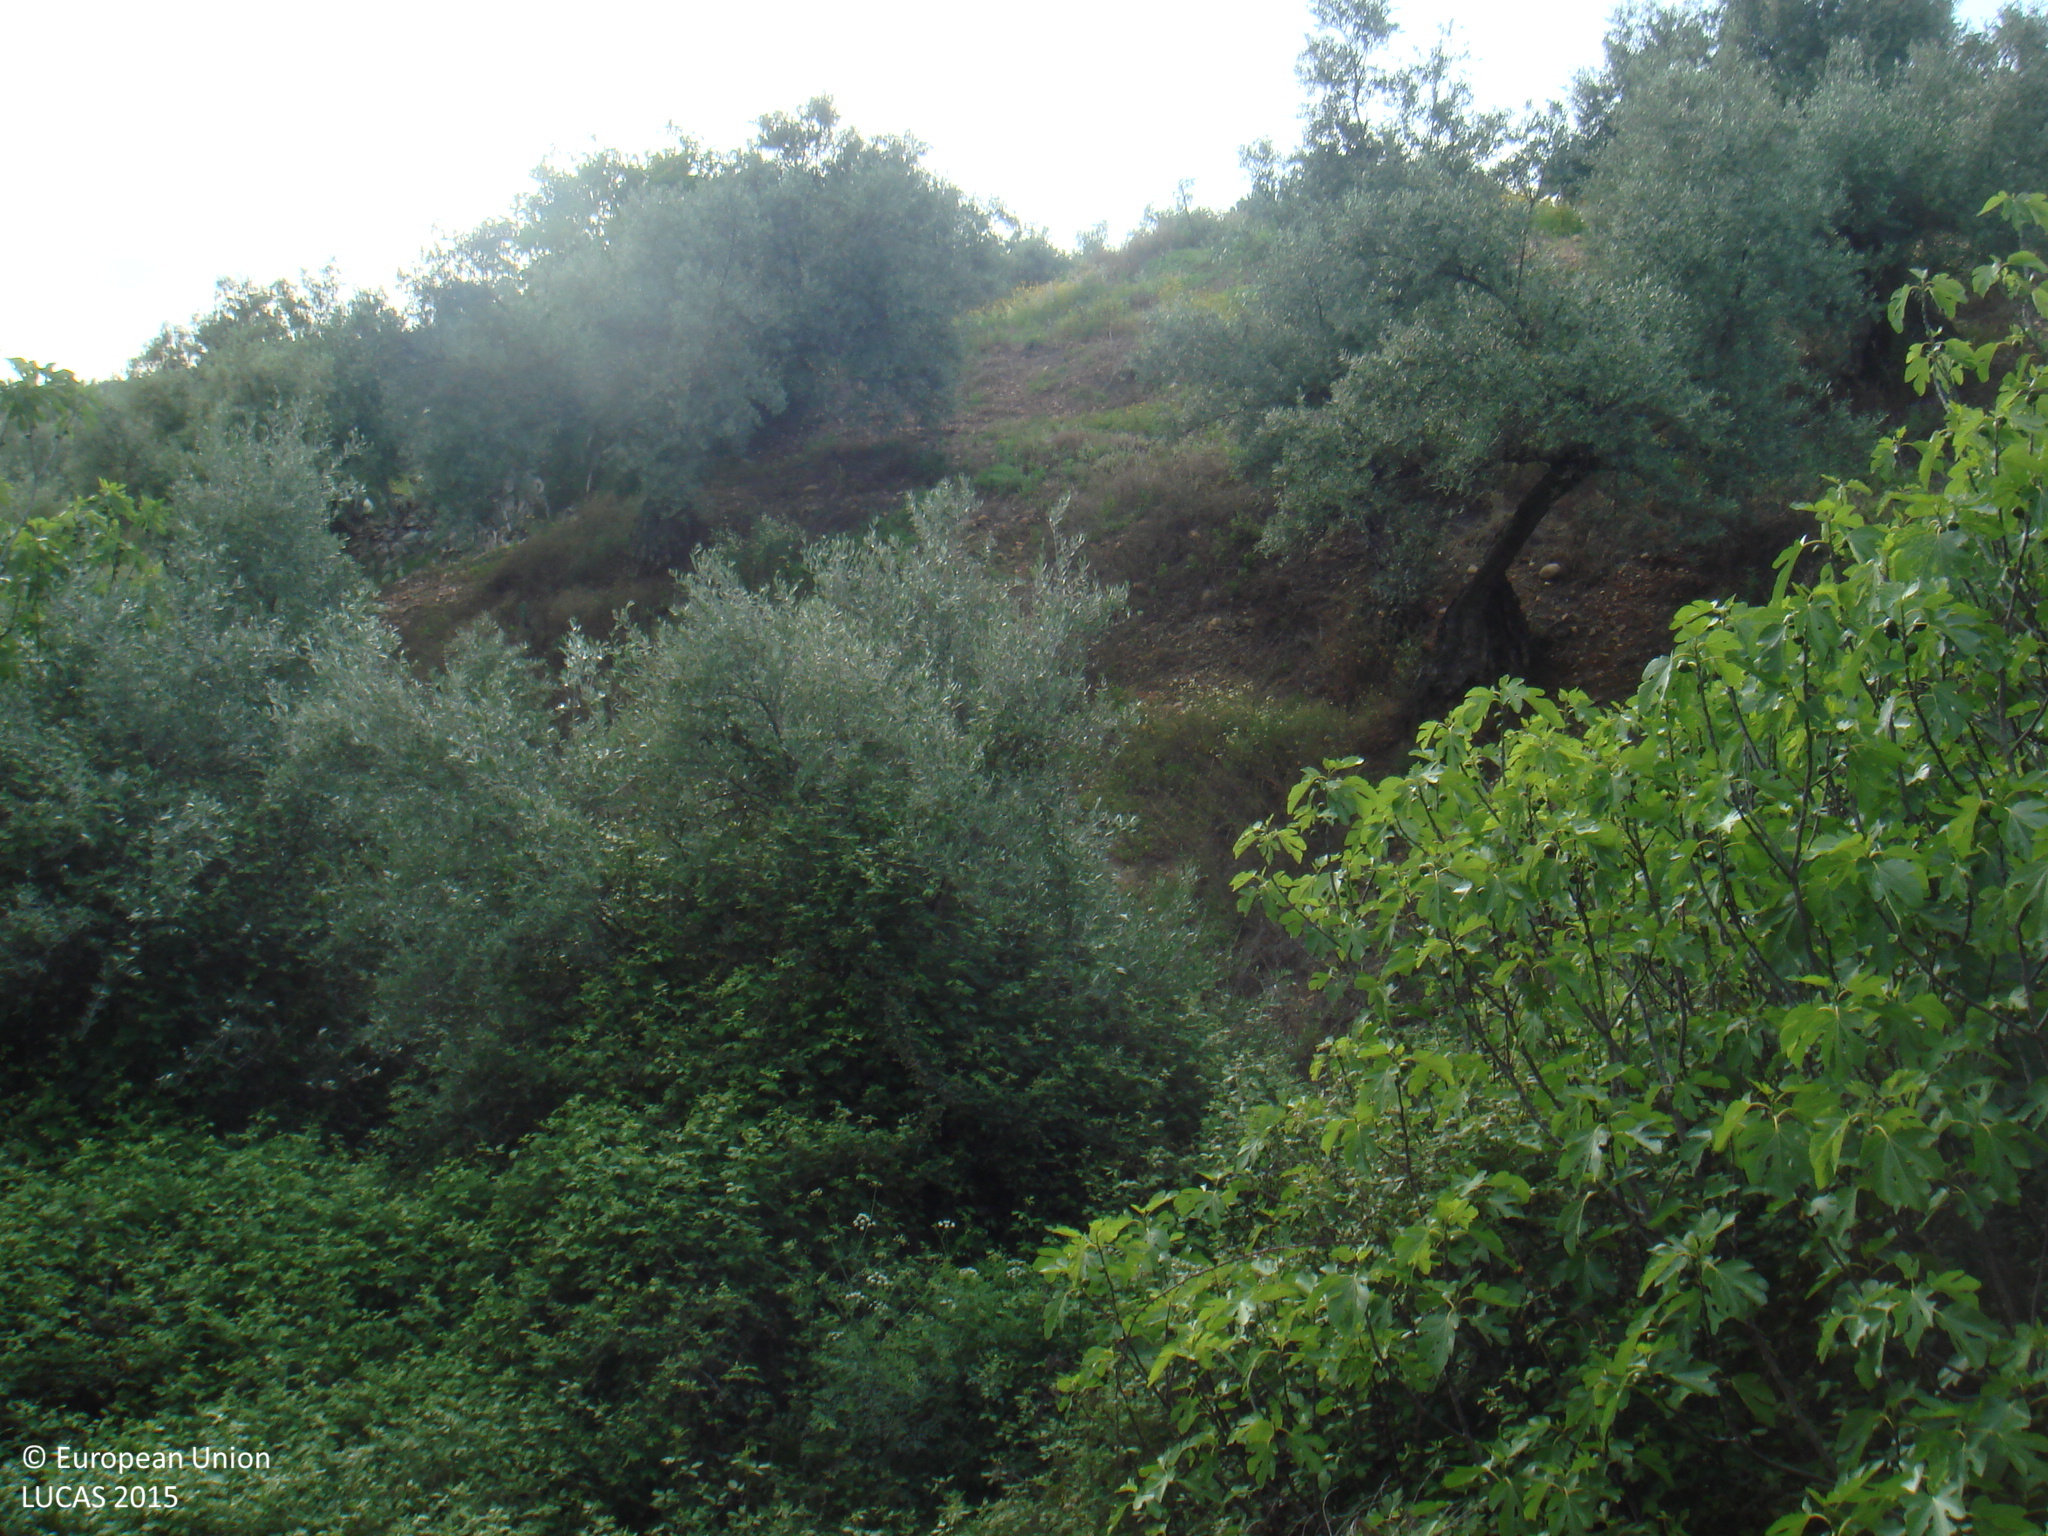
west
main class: Cropland
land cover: Olive groves
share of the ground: 25 - 50 %
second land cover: Other bare soil
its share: > 75 %
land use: Agriculture (excluding fallow land and kitchen gardens)
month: April
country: ES
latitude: 38.0841
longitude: -4.3661
